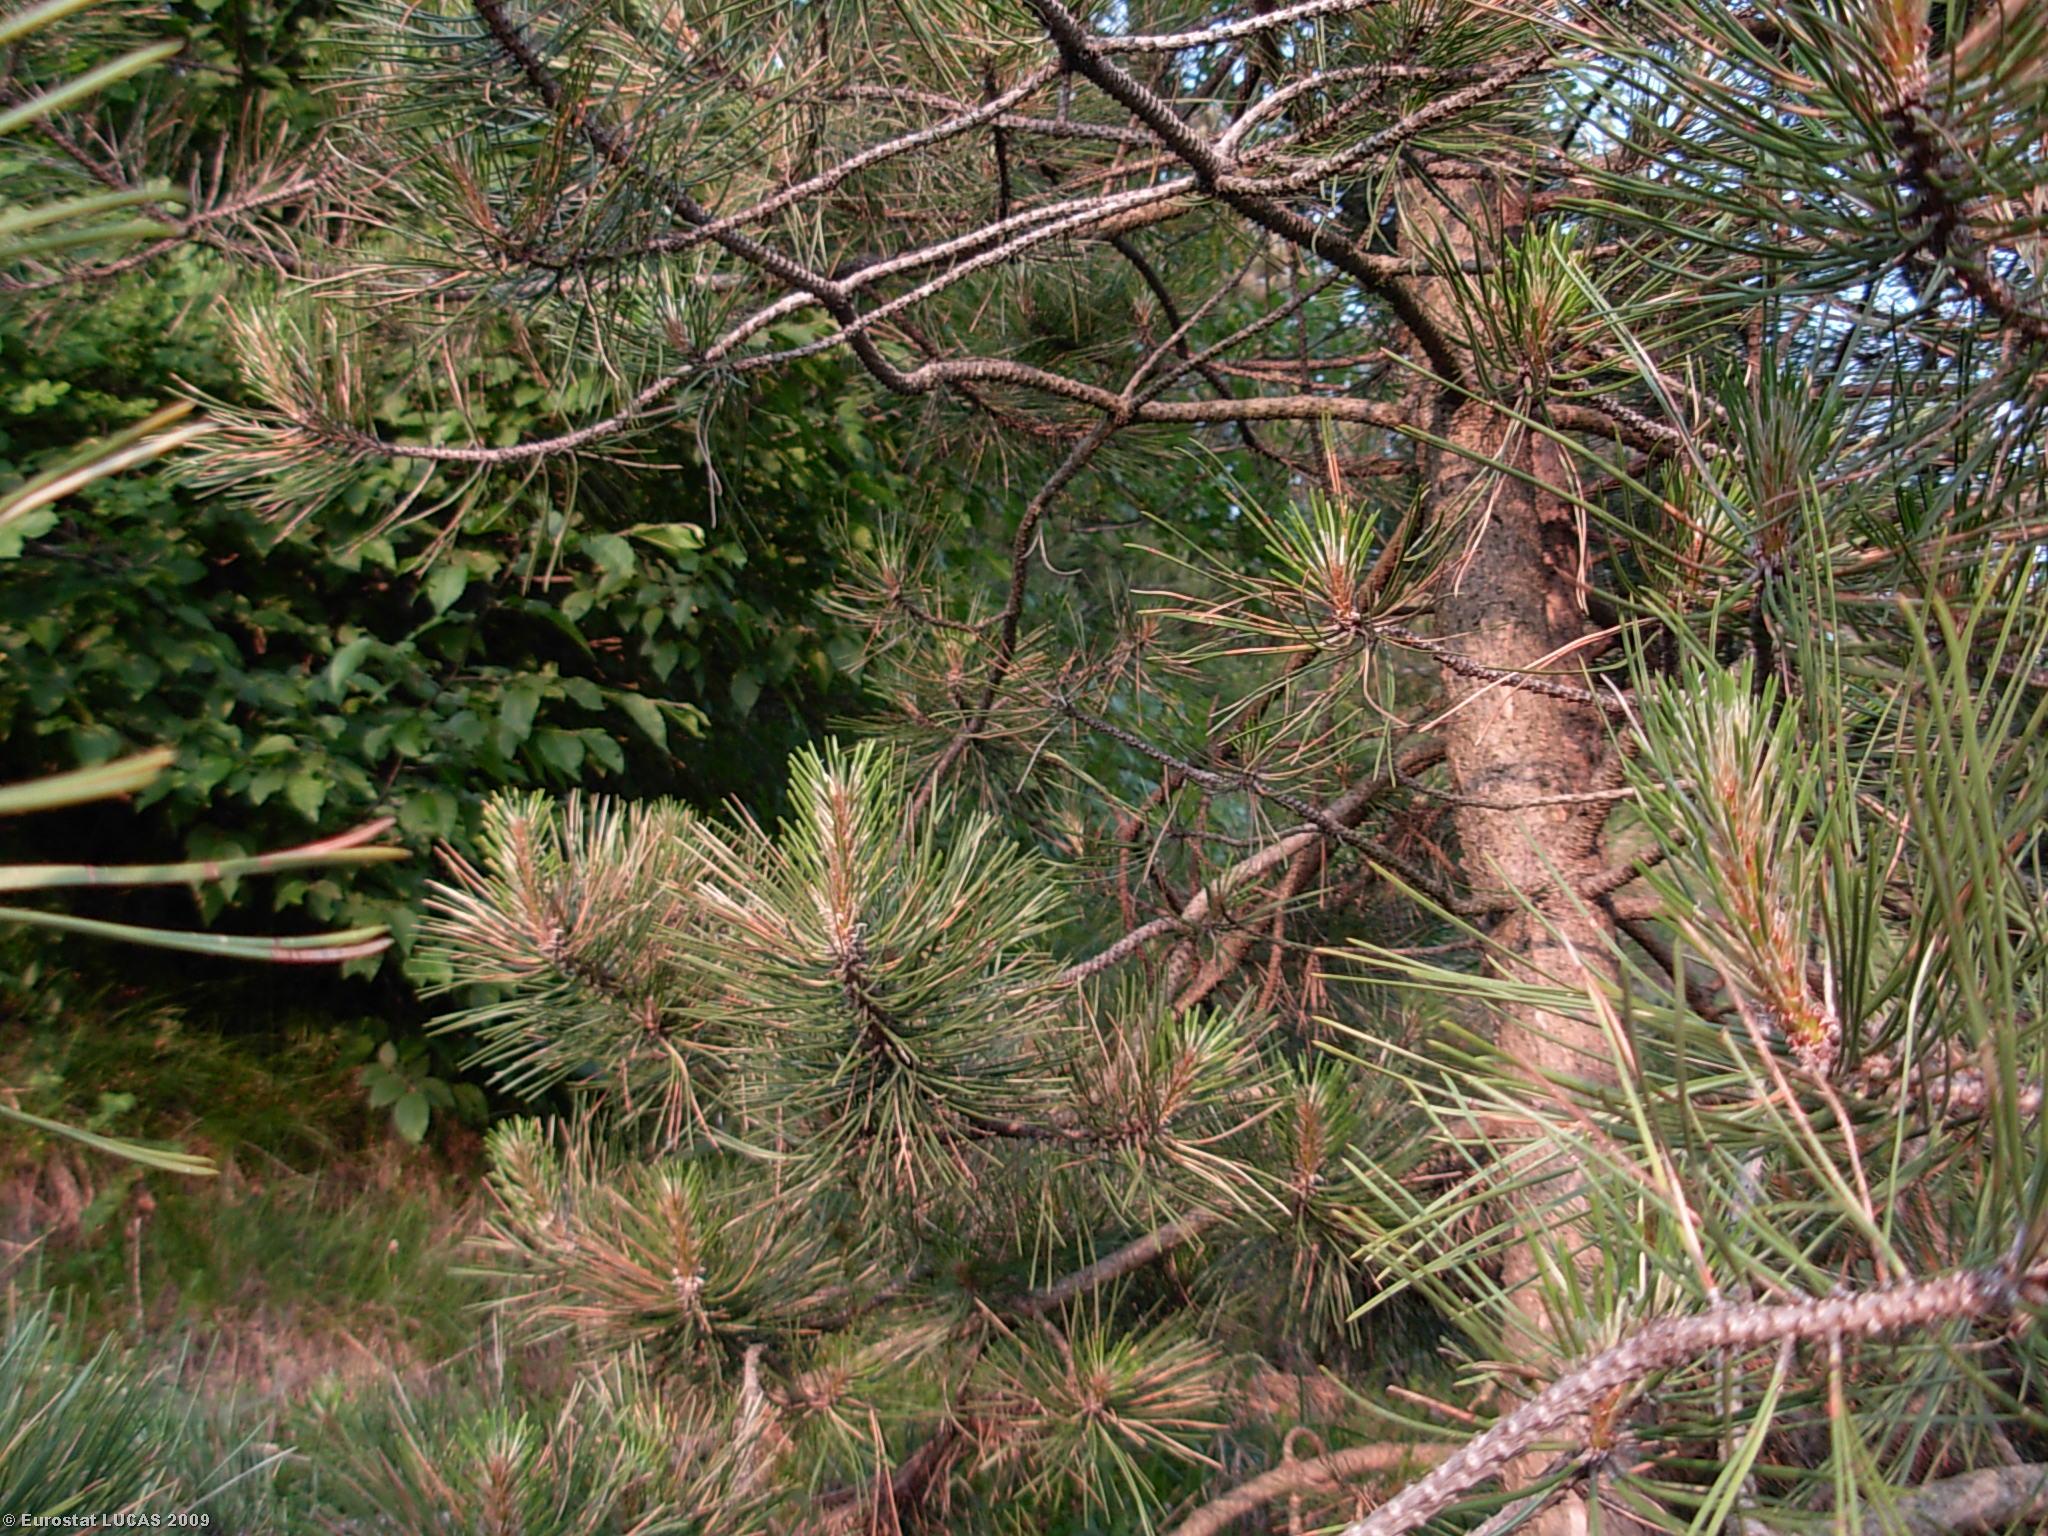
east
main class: Woodland
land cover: Coniferous woodland
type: alpine coniferous forest
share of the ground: > 75 %
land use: Unused
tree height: > 5 m
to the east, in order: Coniferous woodland
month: May
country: IT
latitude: 45.5942
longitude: 10.2688
